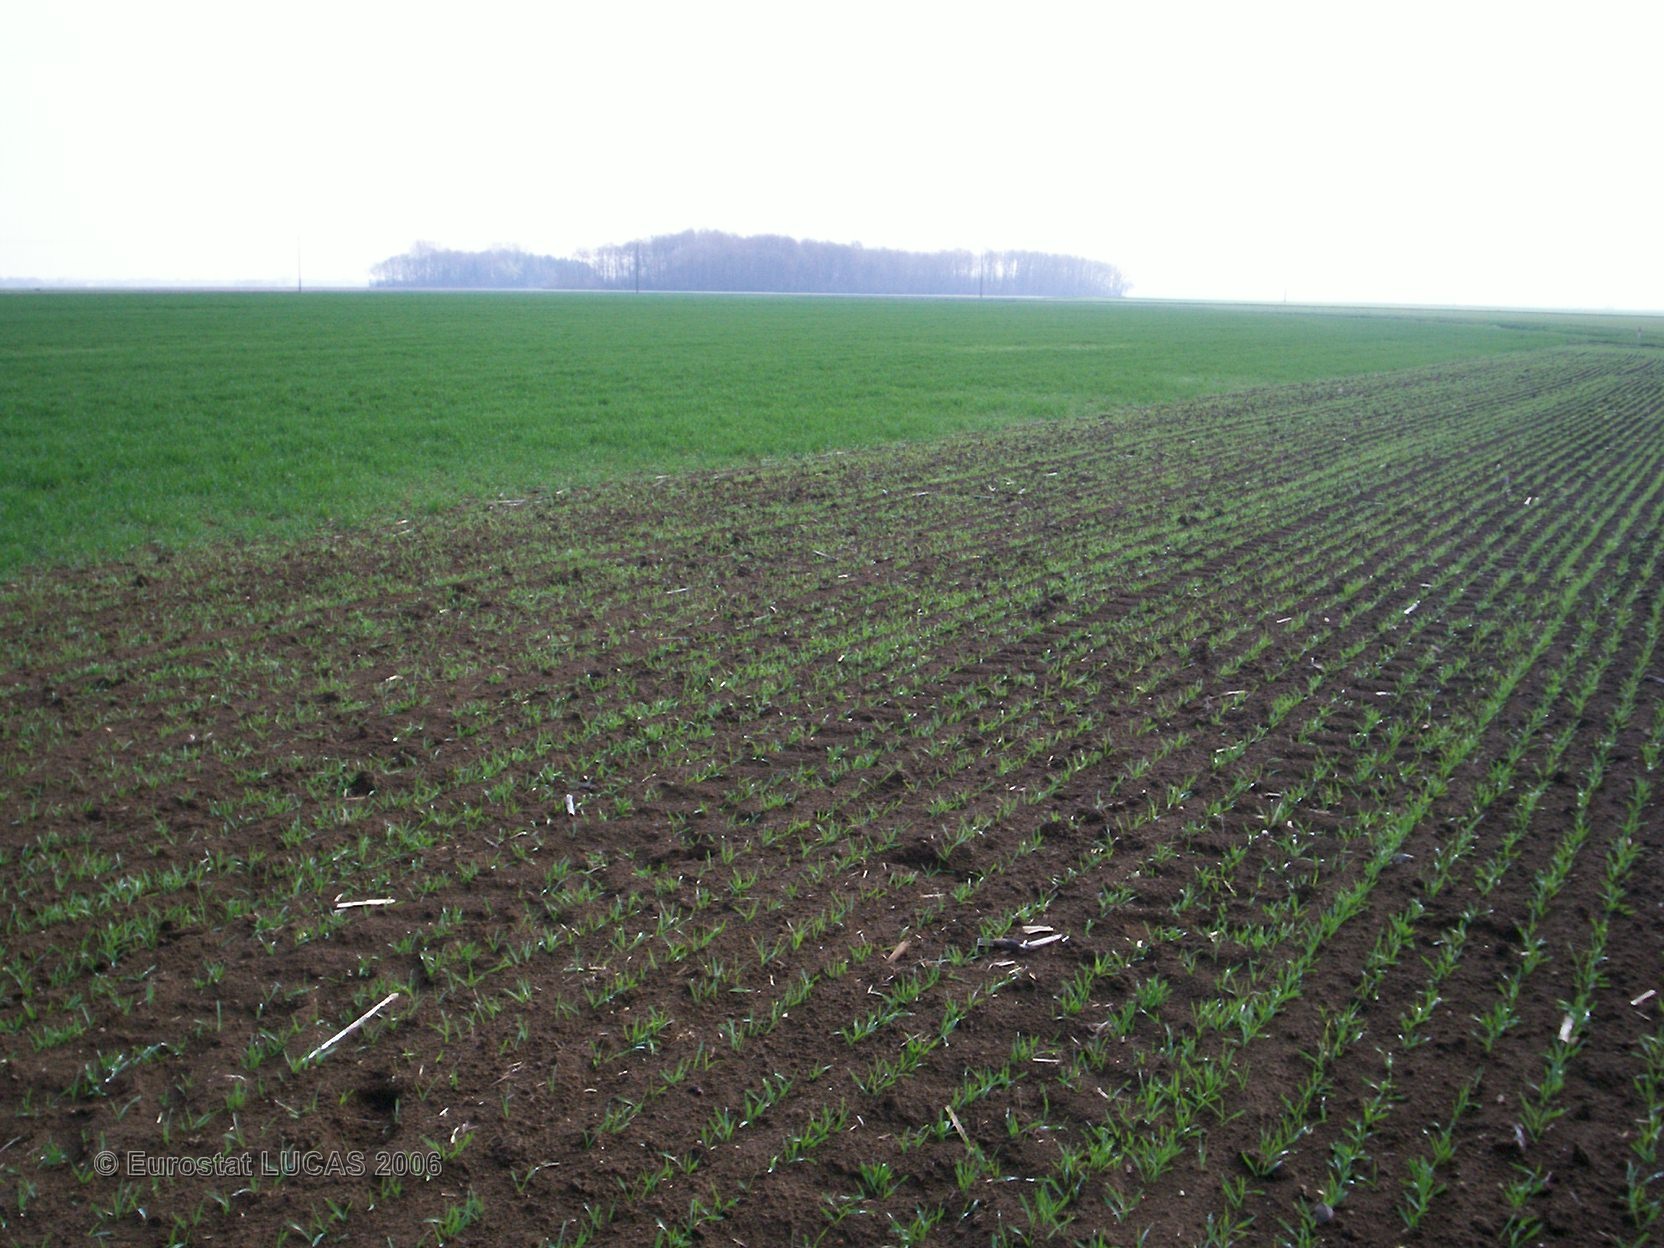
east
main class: Cropland
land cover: Rye
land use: Agriculture (excluding fallow land and kitchen gardens)
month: April
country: FR
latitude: 47.0260
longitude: 5.3569
